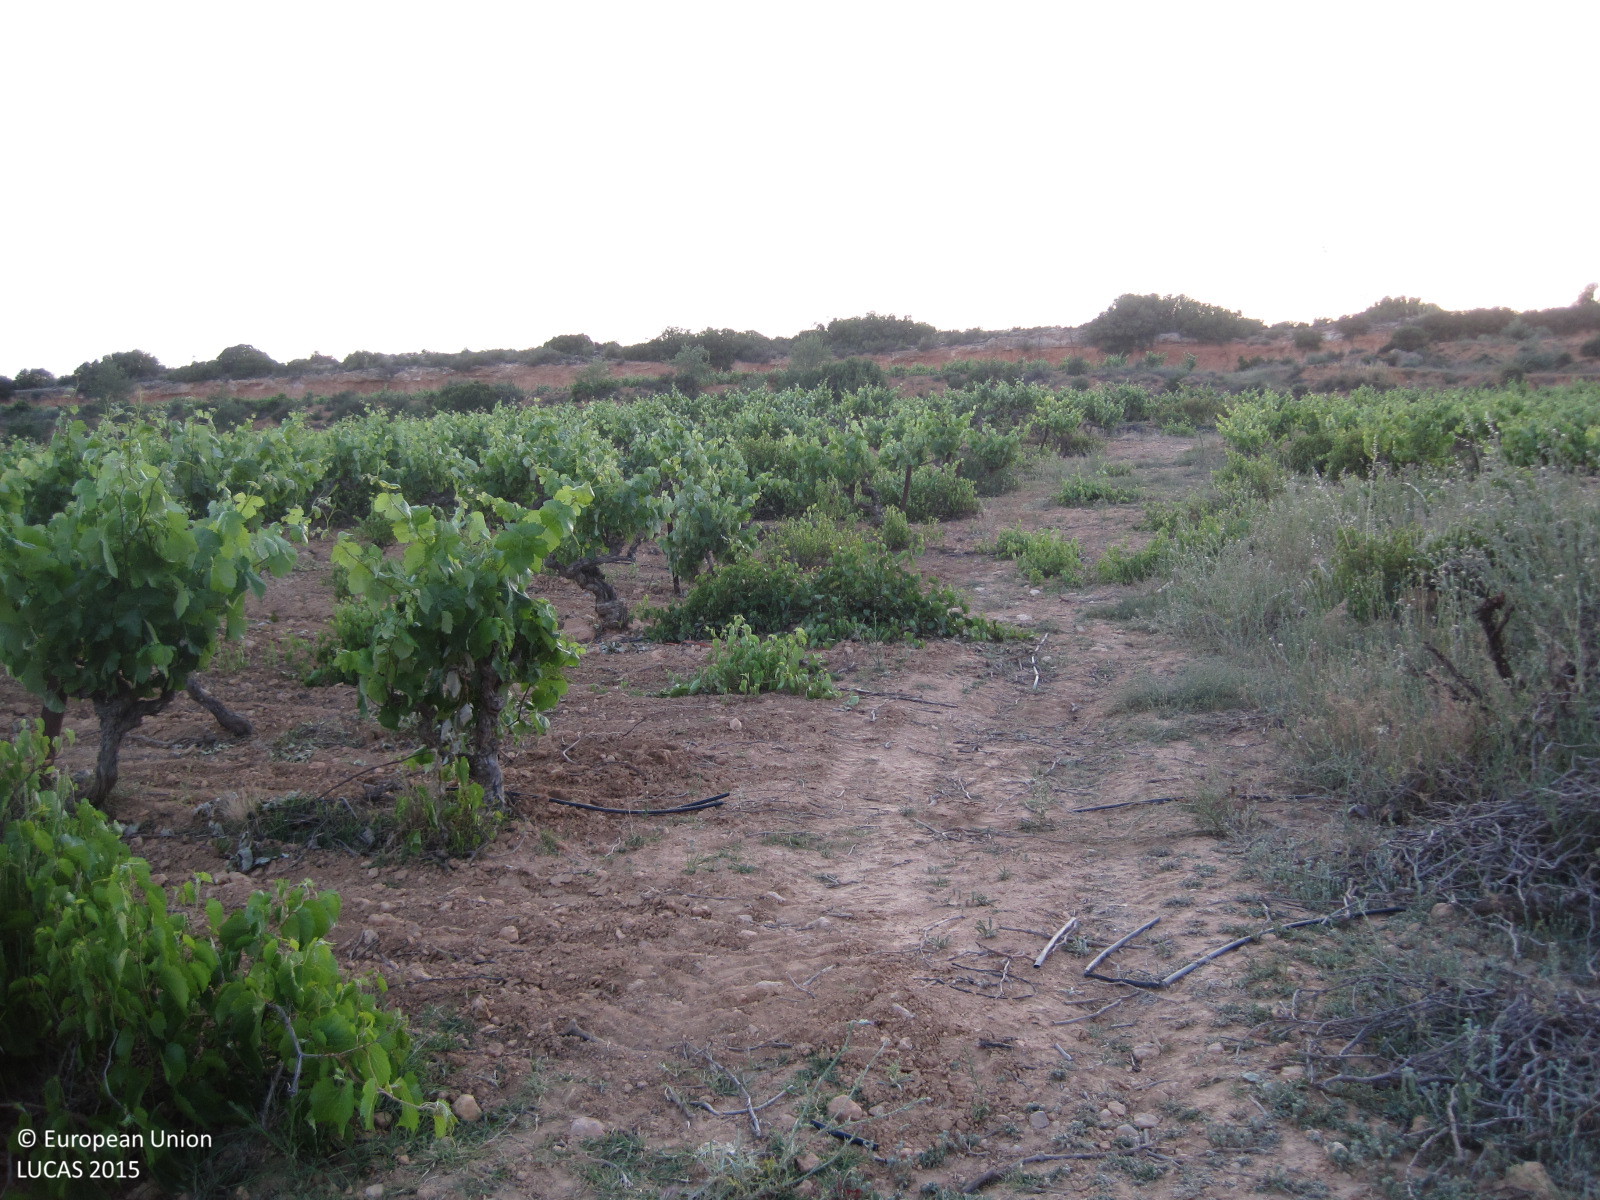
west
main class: Cropland
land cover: Vineyards
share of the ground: 25 - 50 %
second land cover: Other bare soil
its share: > 75 %
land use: Agriculture (excluding fallow land and kitchen gardens)
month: May
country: ES
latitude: 39.5425
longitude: -1.1144
